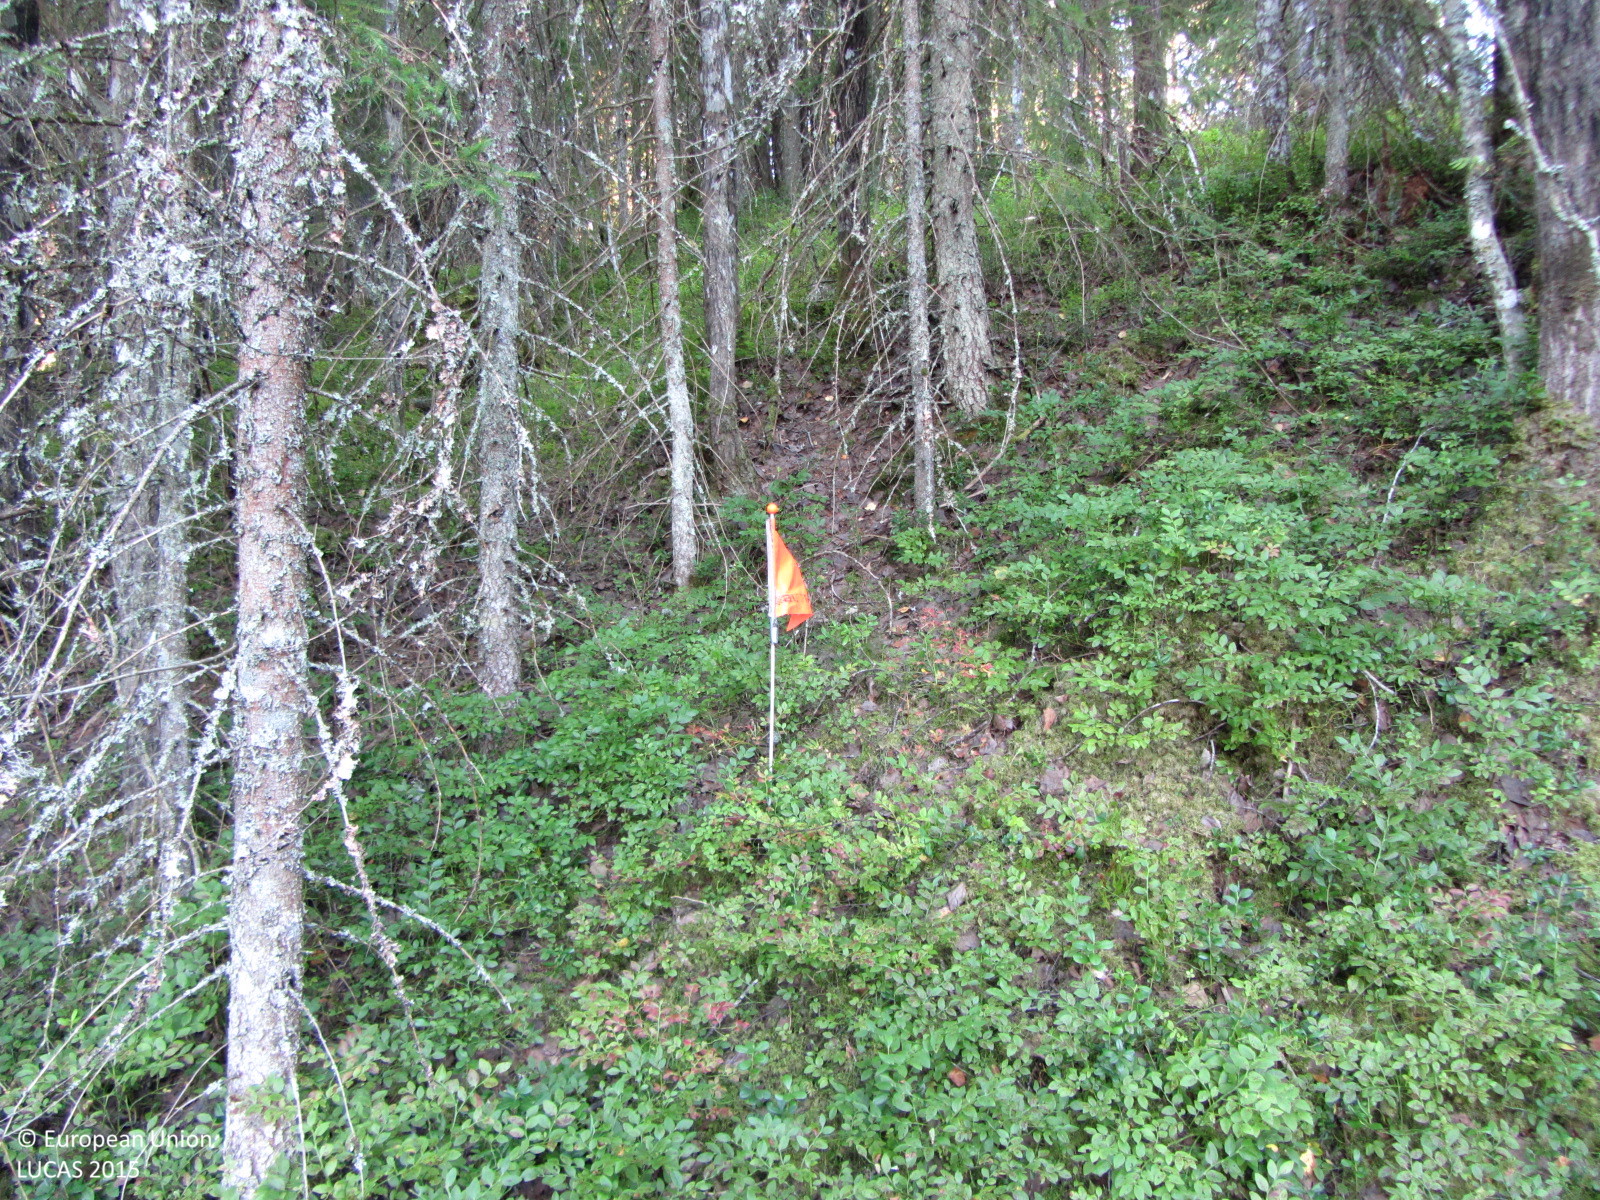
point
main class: Woodland
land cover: Spruce dominated mixed woodland
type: boreal forest
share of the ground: > 75 %
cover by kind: coniferous forest trees 50 %, broadleaved forest trees 30 %, shrubs 15 %, lichens and mosses 5 %
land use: Forestry
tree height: > 5 m
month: August
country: FI
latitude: 60.4419
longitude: 23.8876
